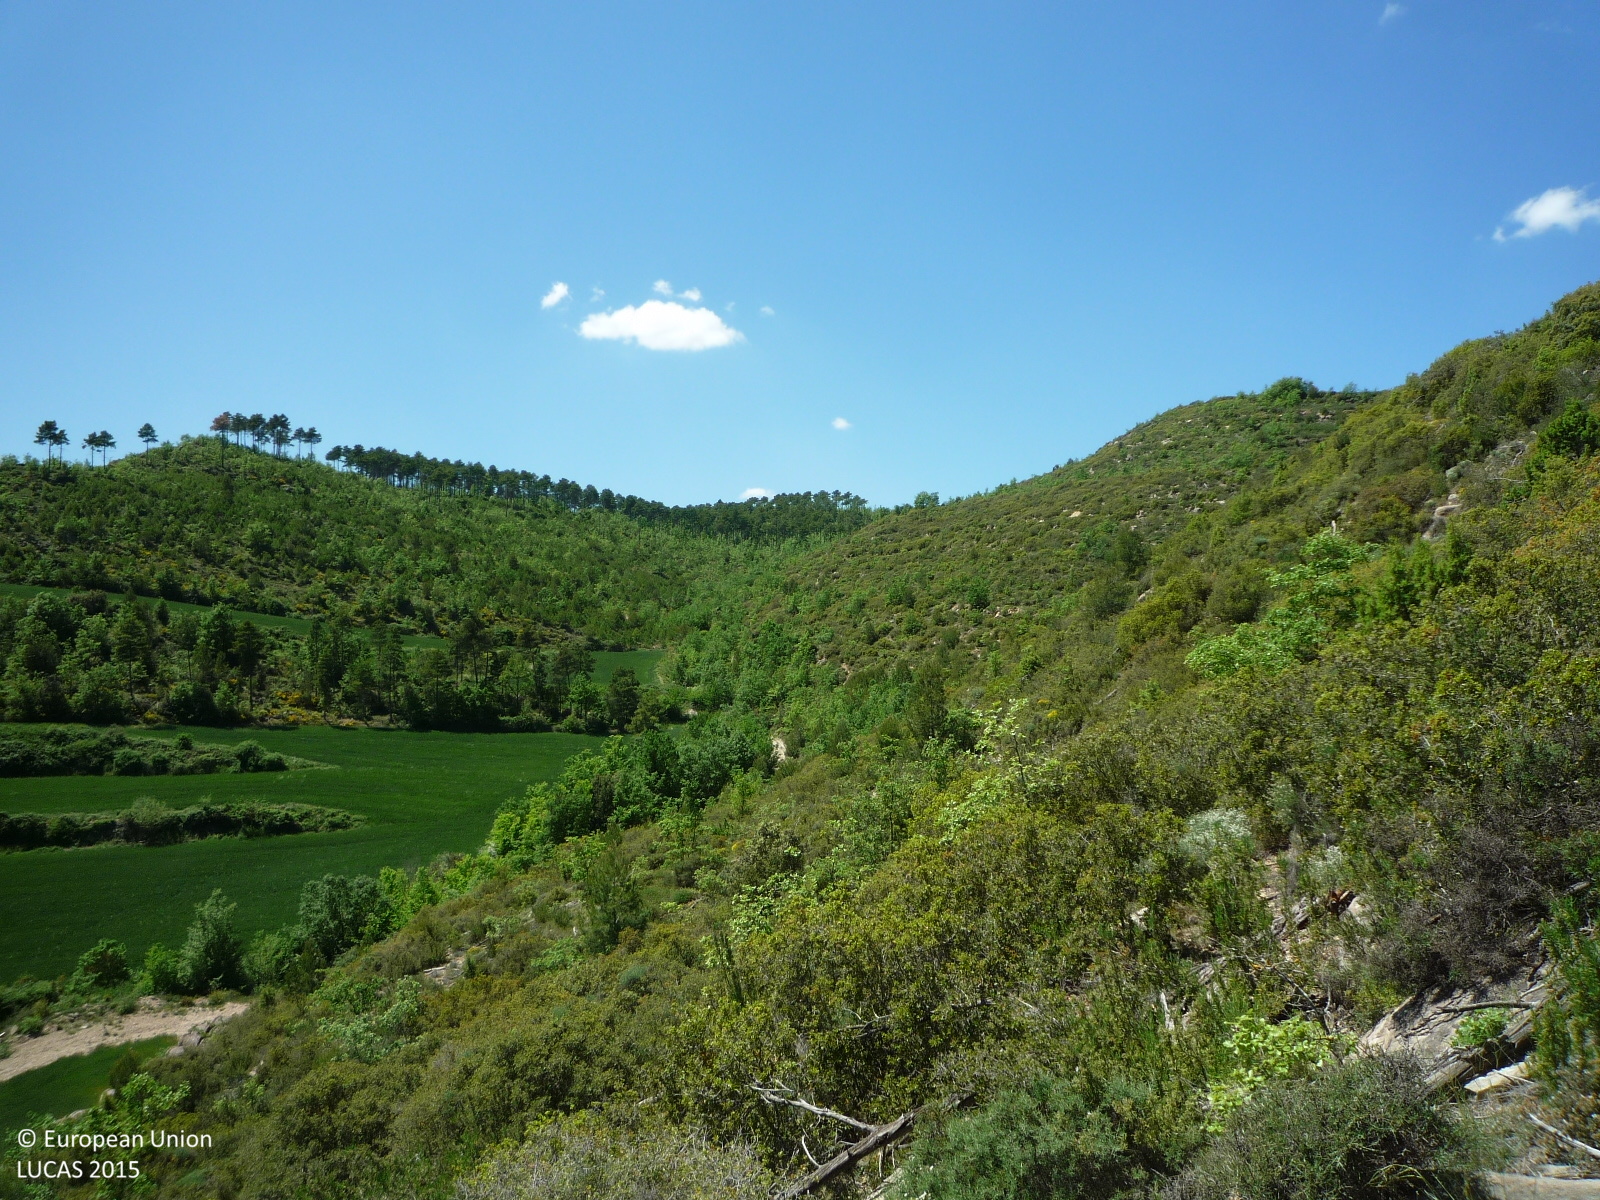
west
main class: Shrubland
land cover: Shrubland with sparse tree cover
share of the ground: > 75 %
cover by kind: shrubs 95 %, coniferous forest trees 5 %
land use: Semi-natural and natural areas not in use
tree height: < 5 m
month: May
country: ES
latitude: 41.8165
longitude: 1.6234
